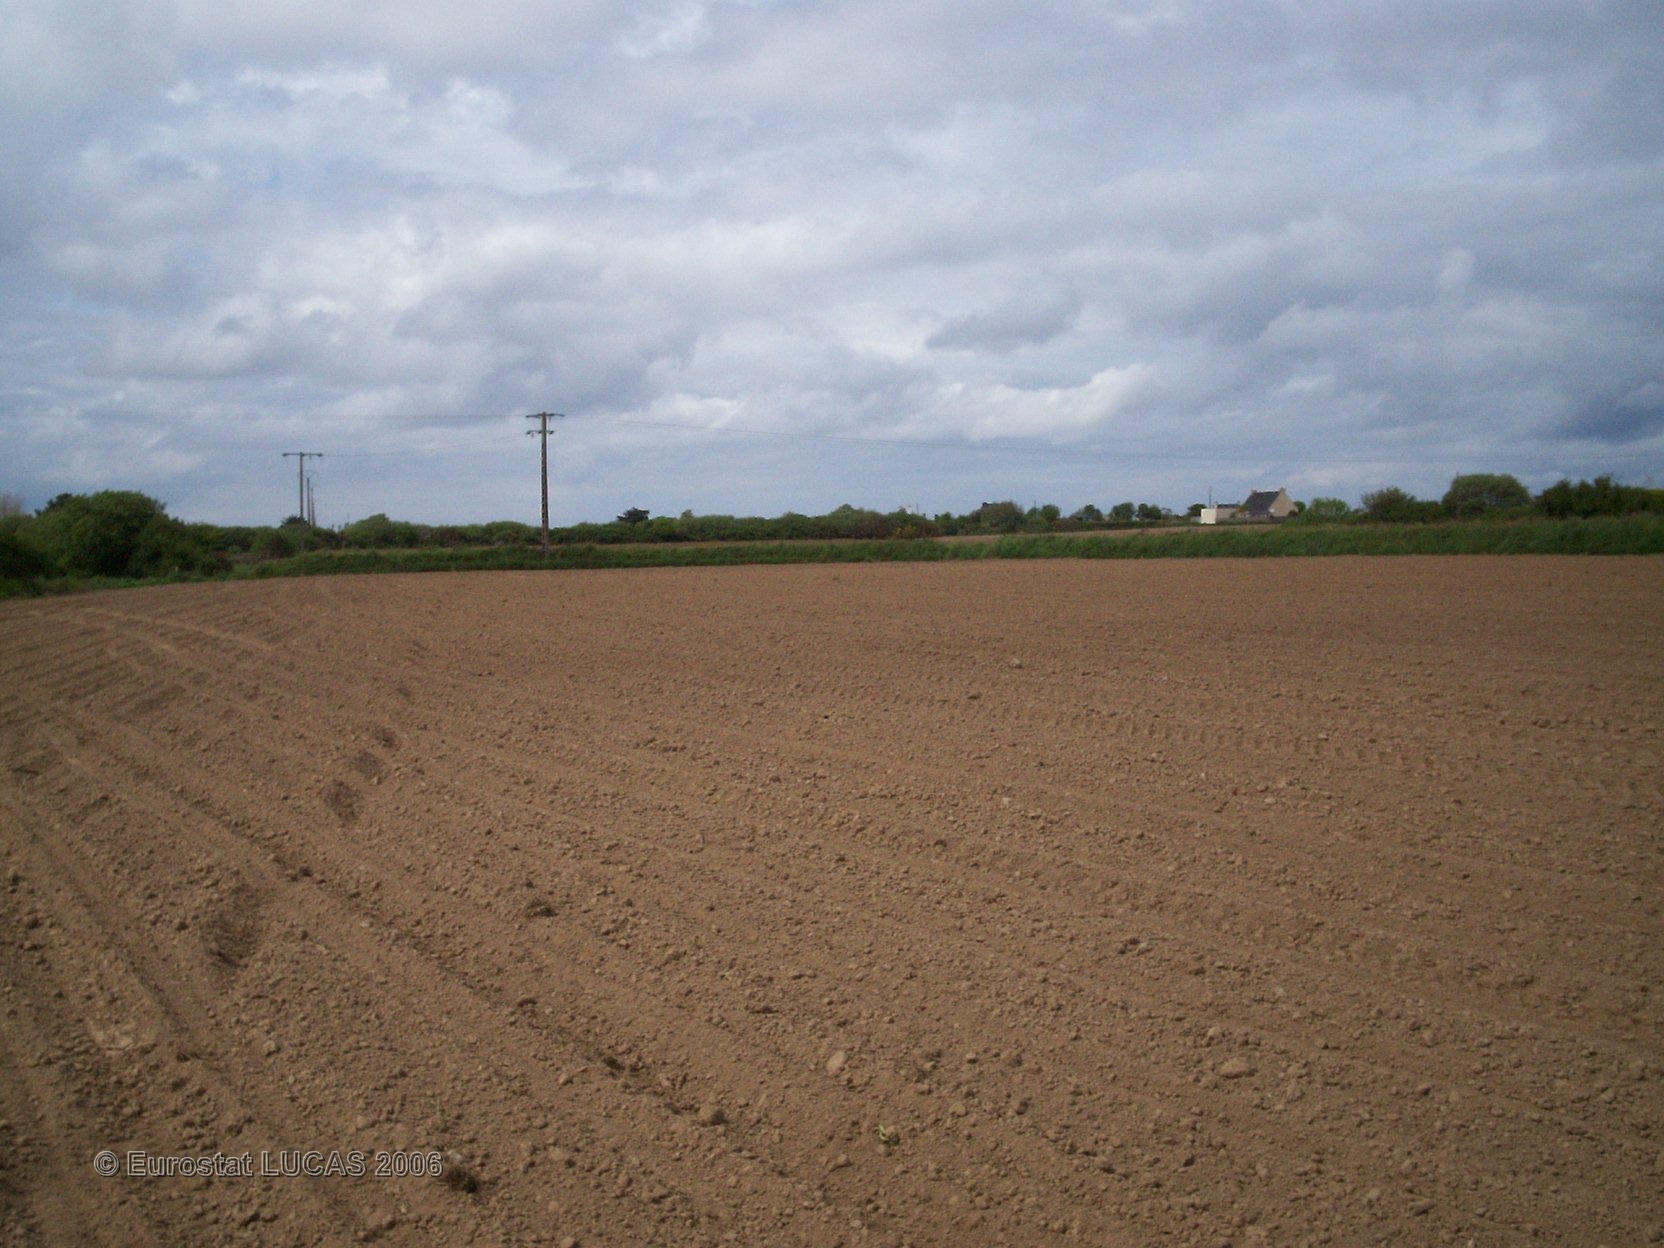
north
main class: Cropland
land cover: Maize
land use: Agriculture (excluding fallow land and kitchen gardens)
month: May
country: FR
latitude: 48.6731
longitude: -3.7320
